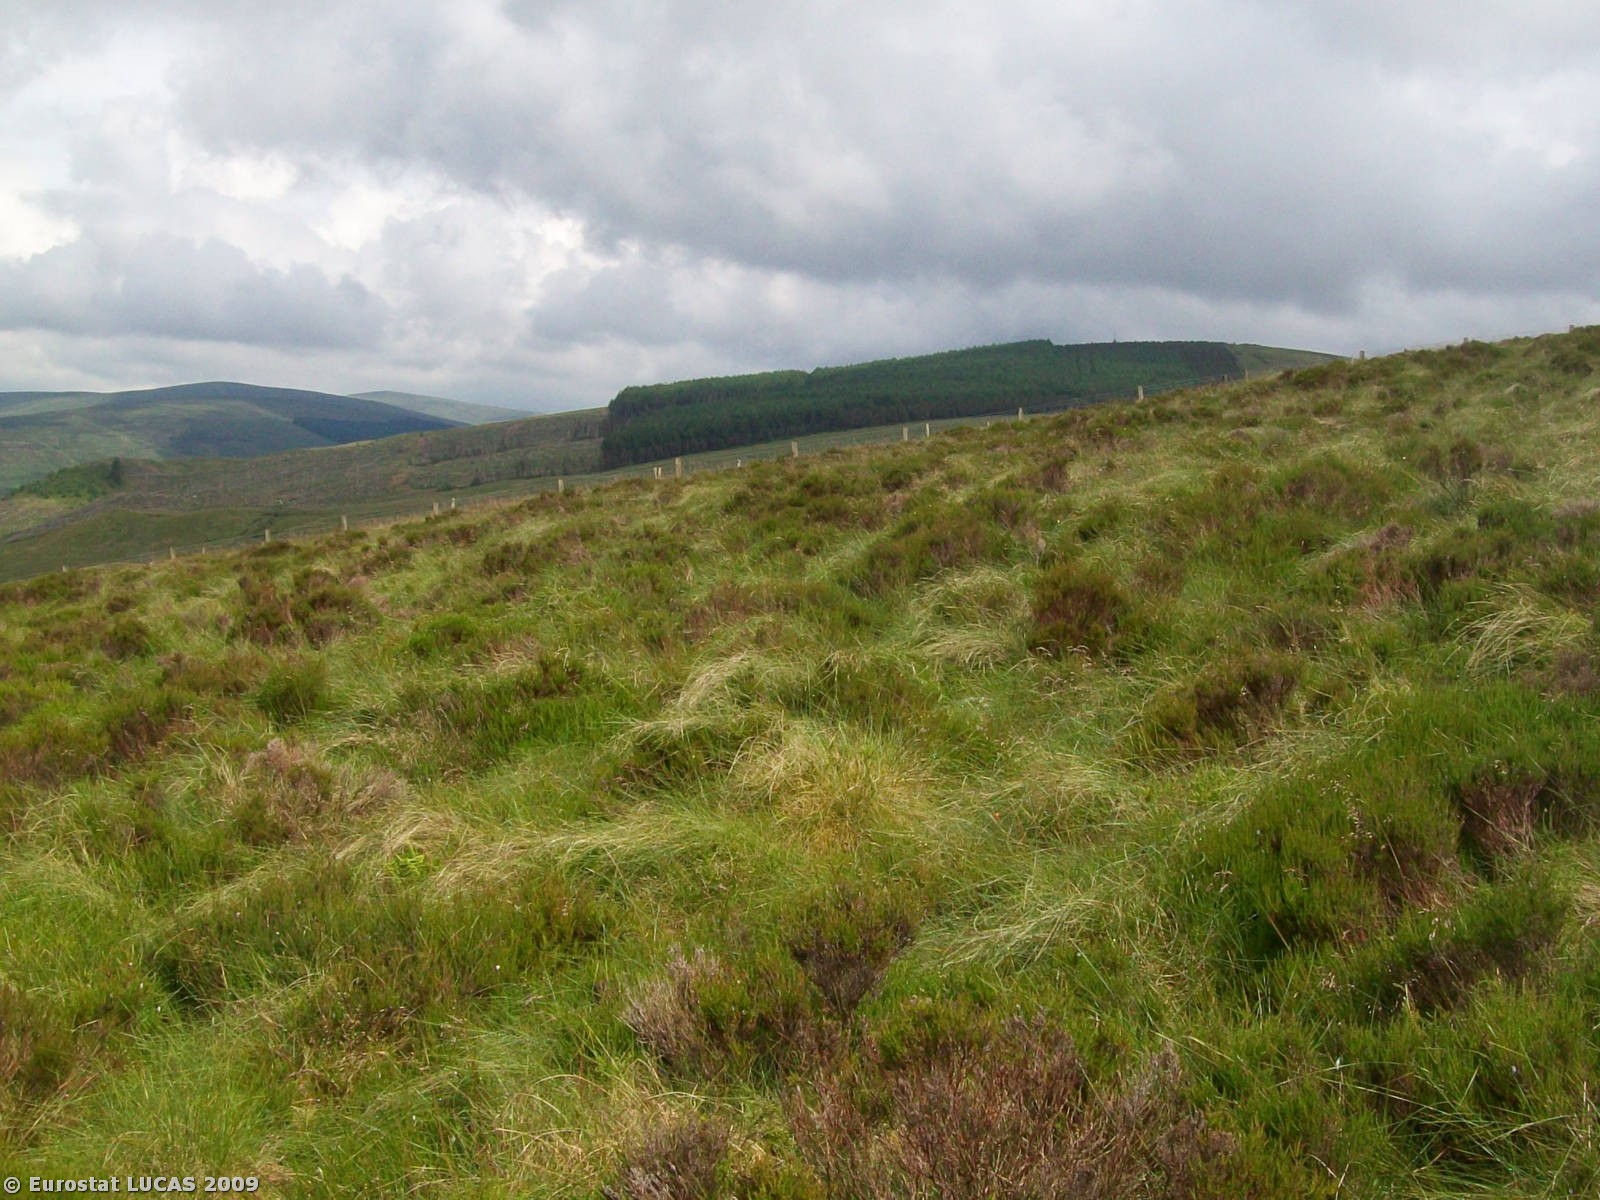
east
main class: Wetlands
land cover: Peatbogs
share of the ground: > 75 %
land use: Unused
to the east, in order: Peatbogs; Rivers and streams; Peatbogs
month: July
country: GB
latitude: 54.7681
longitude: -6.9713
